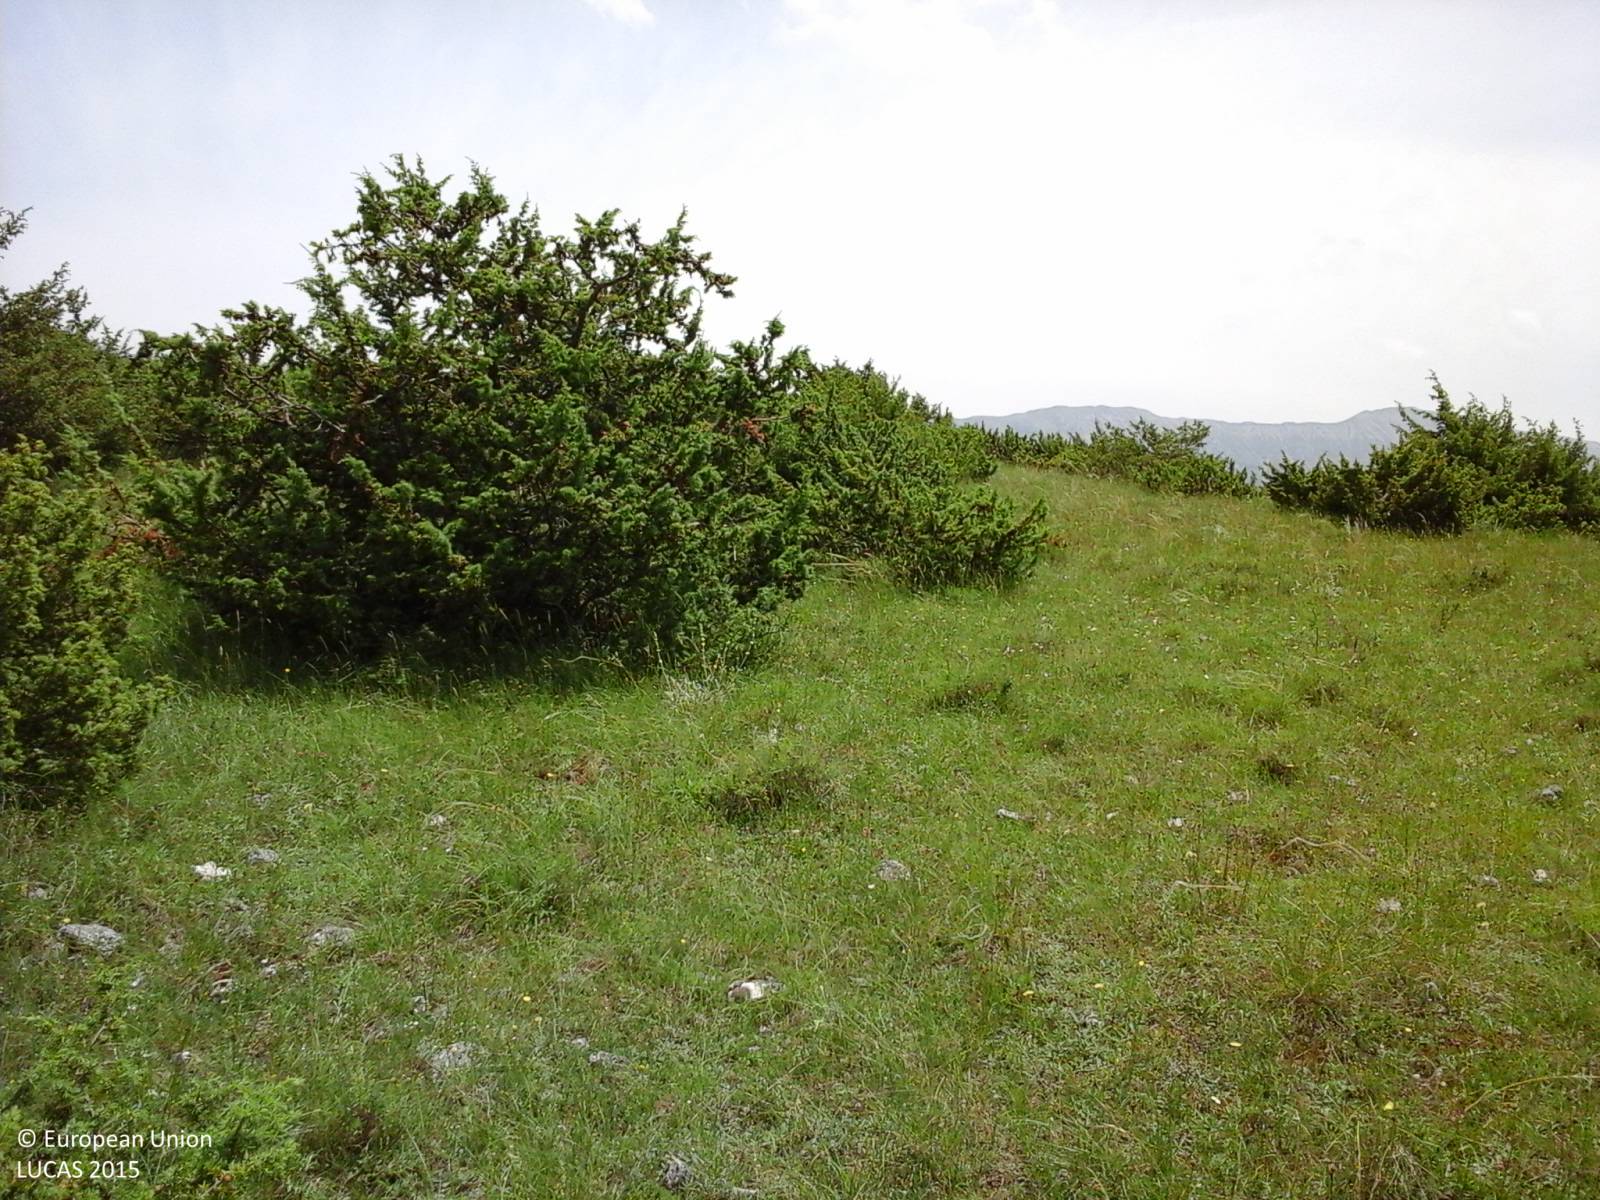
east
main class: Shrubland
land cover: Shrubland without tree cover
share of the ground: > 75 %
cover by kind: herbaceous plants 60 %, shrubs 40 %
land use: Agriculture (excluding fallow land and kitchen gardens)
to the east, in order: Shrubland without tree cover; Grassland with sparse tree/shrub cover; Shrubland without tree cover; Broadleaved woodland; Shrubland with sparse tree cover; Broadleaved woodland; Shrubland with sparse tree cover
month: June
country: IT
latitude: 41.9960
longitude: 14.0066
